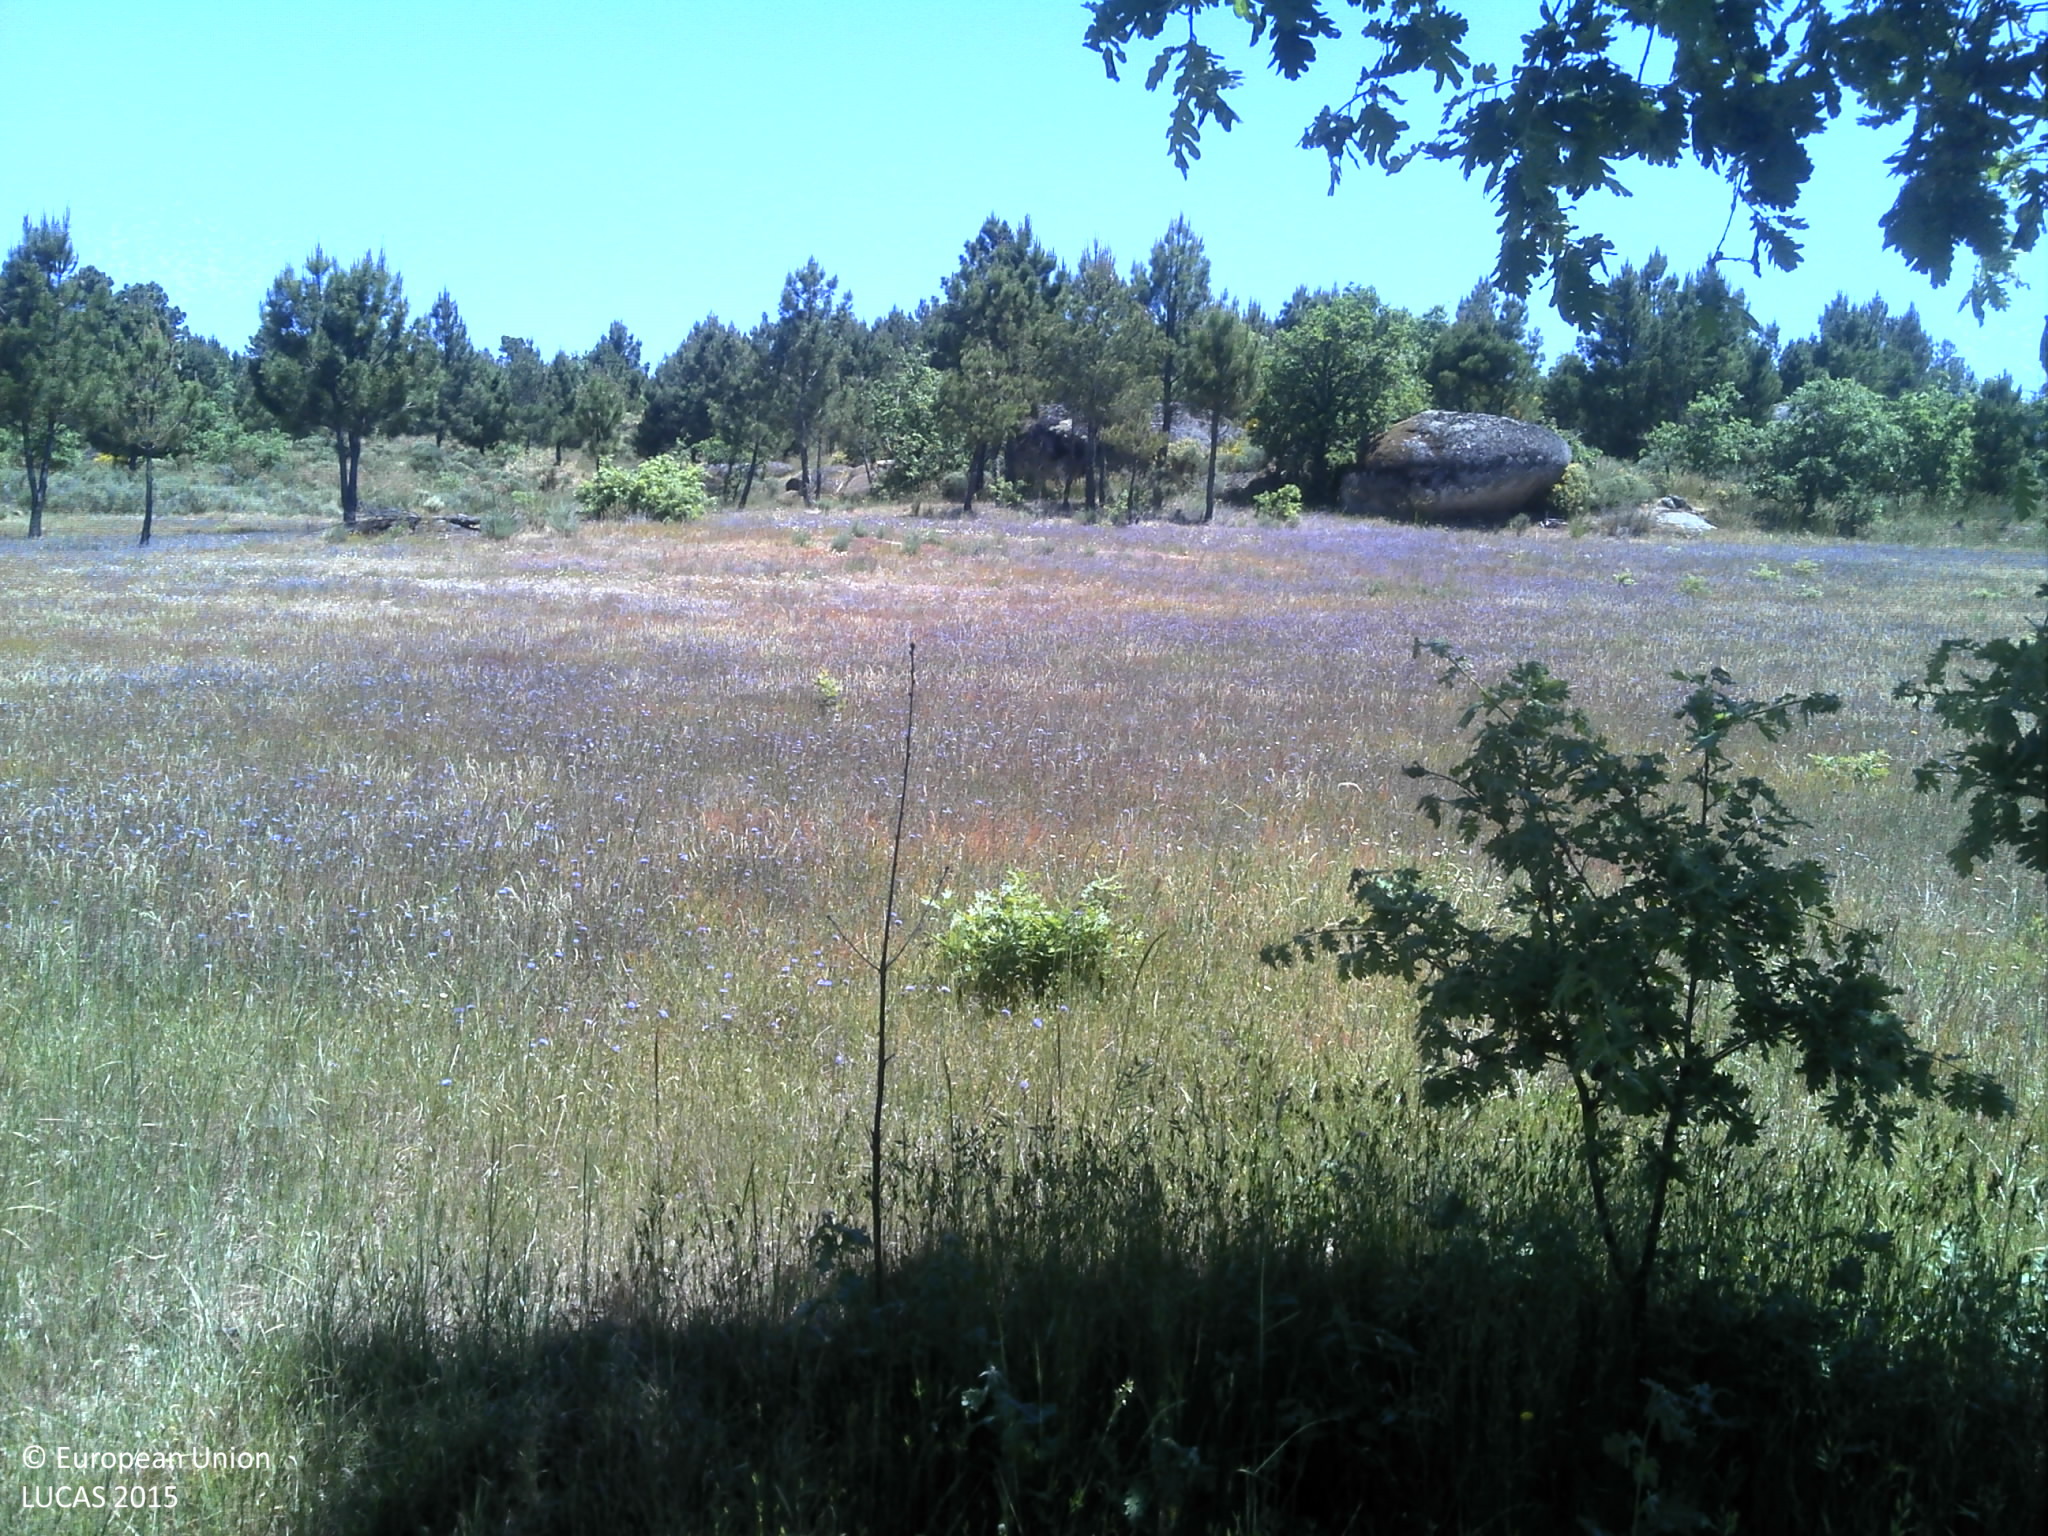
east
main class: Shrubland
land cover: Shrubland with sparse tree cover
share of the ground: 50 - 75 %
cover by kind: shrubs 65 %, herbaceous plants 15 %, unconsolidated bare surface 10 %, broadleaved forest trees 5 %
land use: Semi-natural and natural areas not in use
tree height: > 5 m
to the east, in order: Shrubland with sparse tree cover; Dry stone walls; Tracks; Grassland without tree/shrub cover; Dry stone walls; Spontaneously vegetated surfaces; Shrubland with sparse tree cover; Rocks and stones; Shrubland with sparse tree cover; Rocks and stones
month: May
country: PT
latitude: 40.5664
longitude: -7.1715
